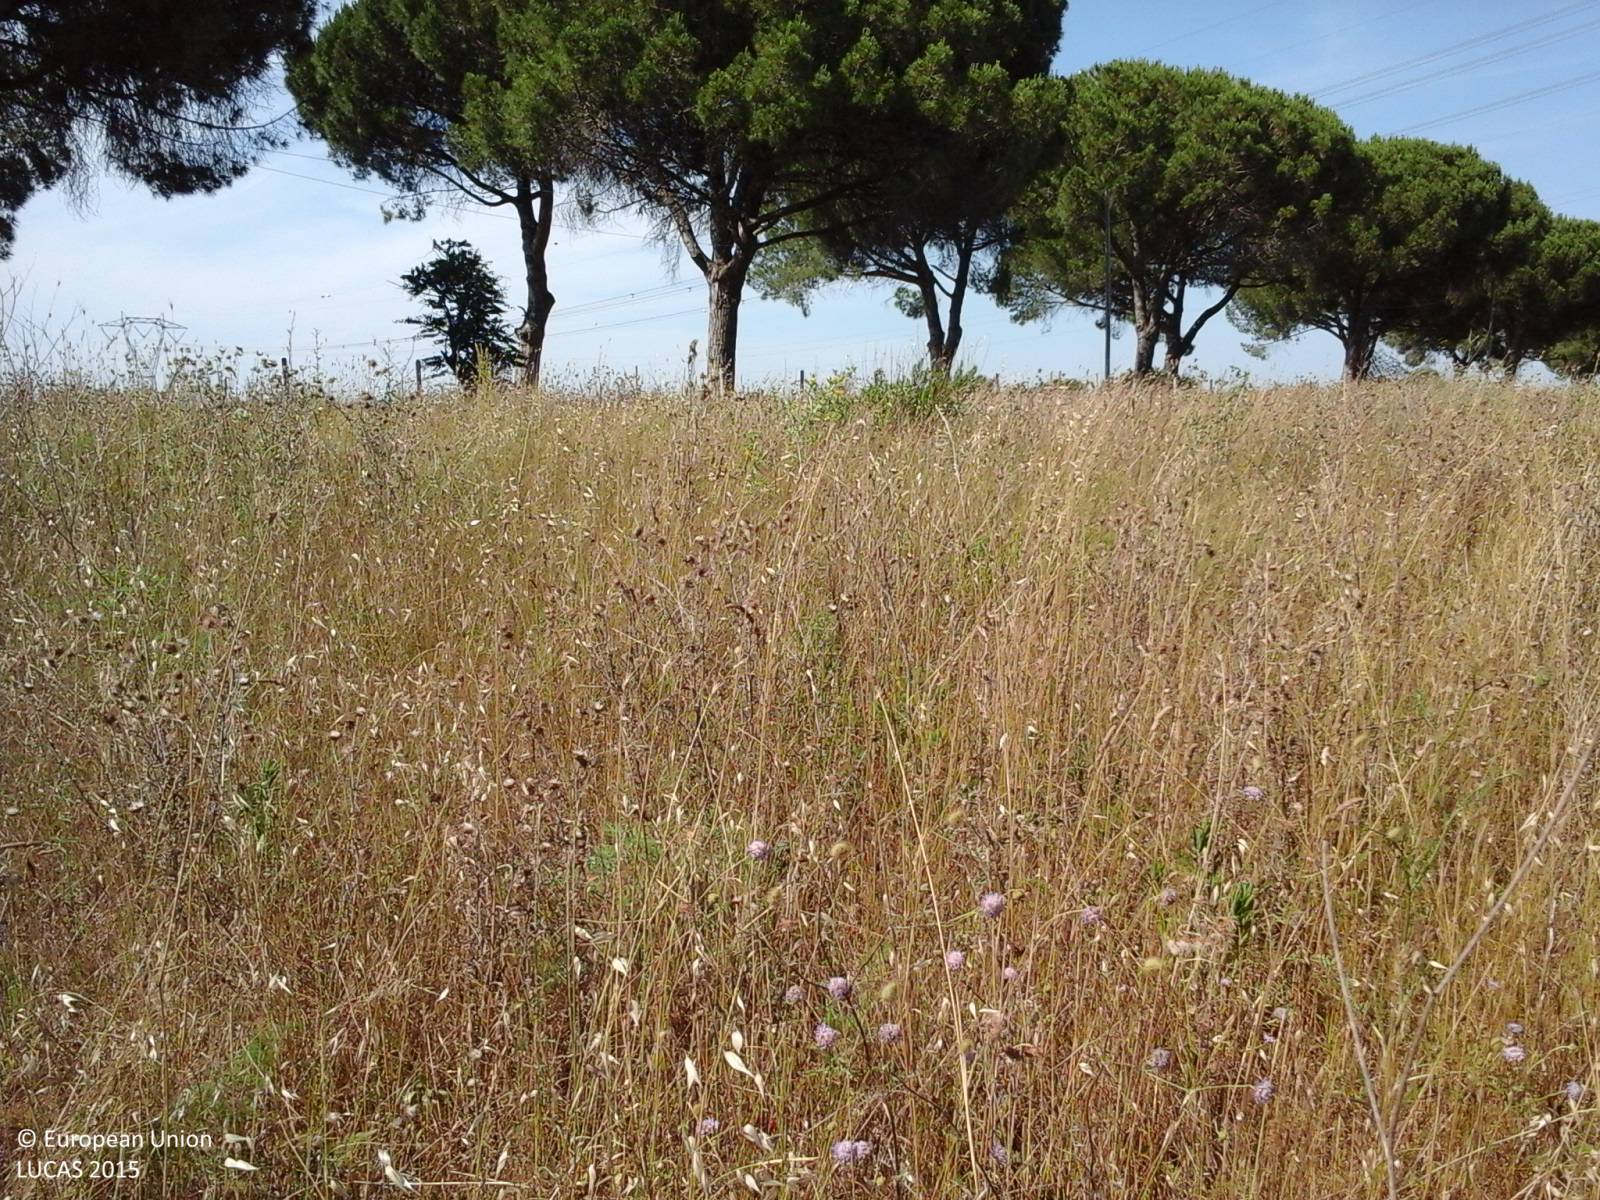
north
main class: Grassland
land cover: Grassland without tree/shrub cover
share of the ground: > 75 %
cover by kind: herbaceous plants 100 %
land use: Semi-natural and natural areas not in use
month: June
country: IT
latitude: 41.8504
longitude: 12.3158
